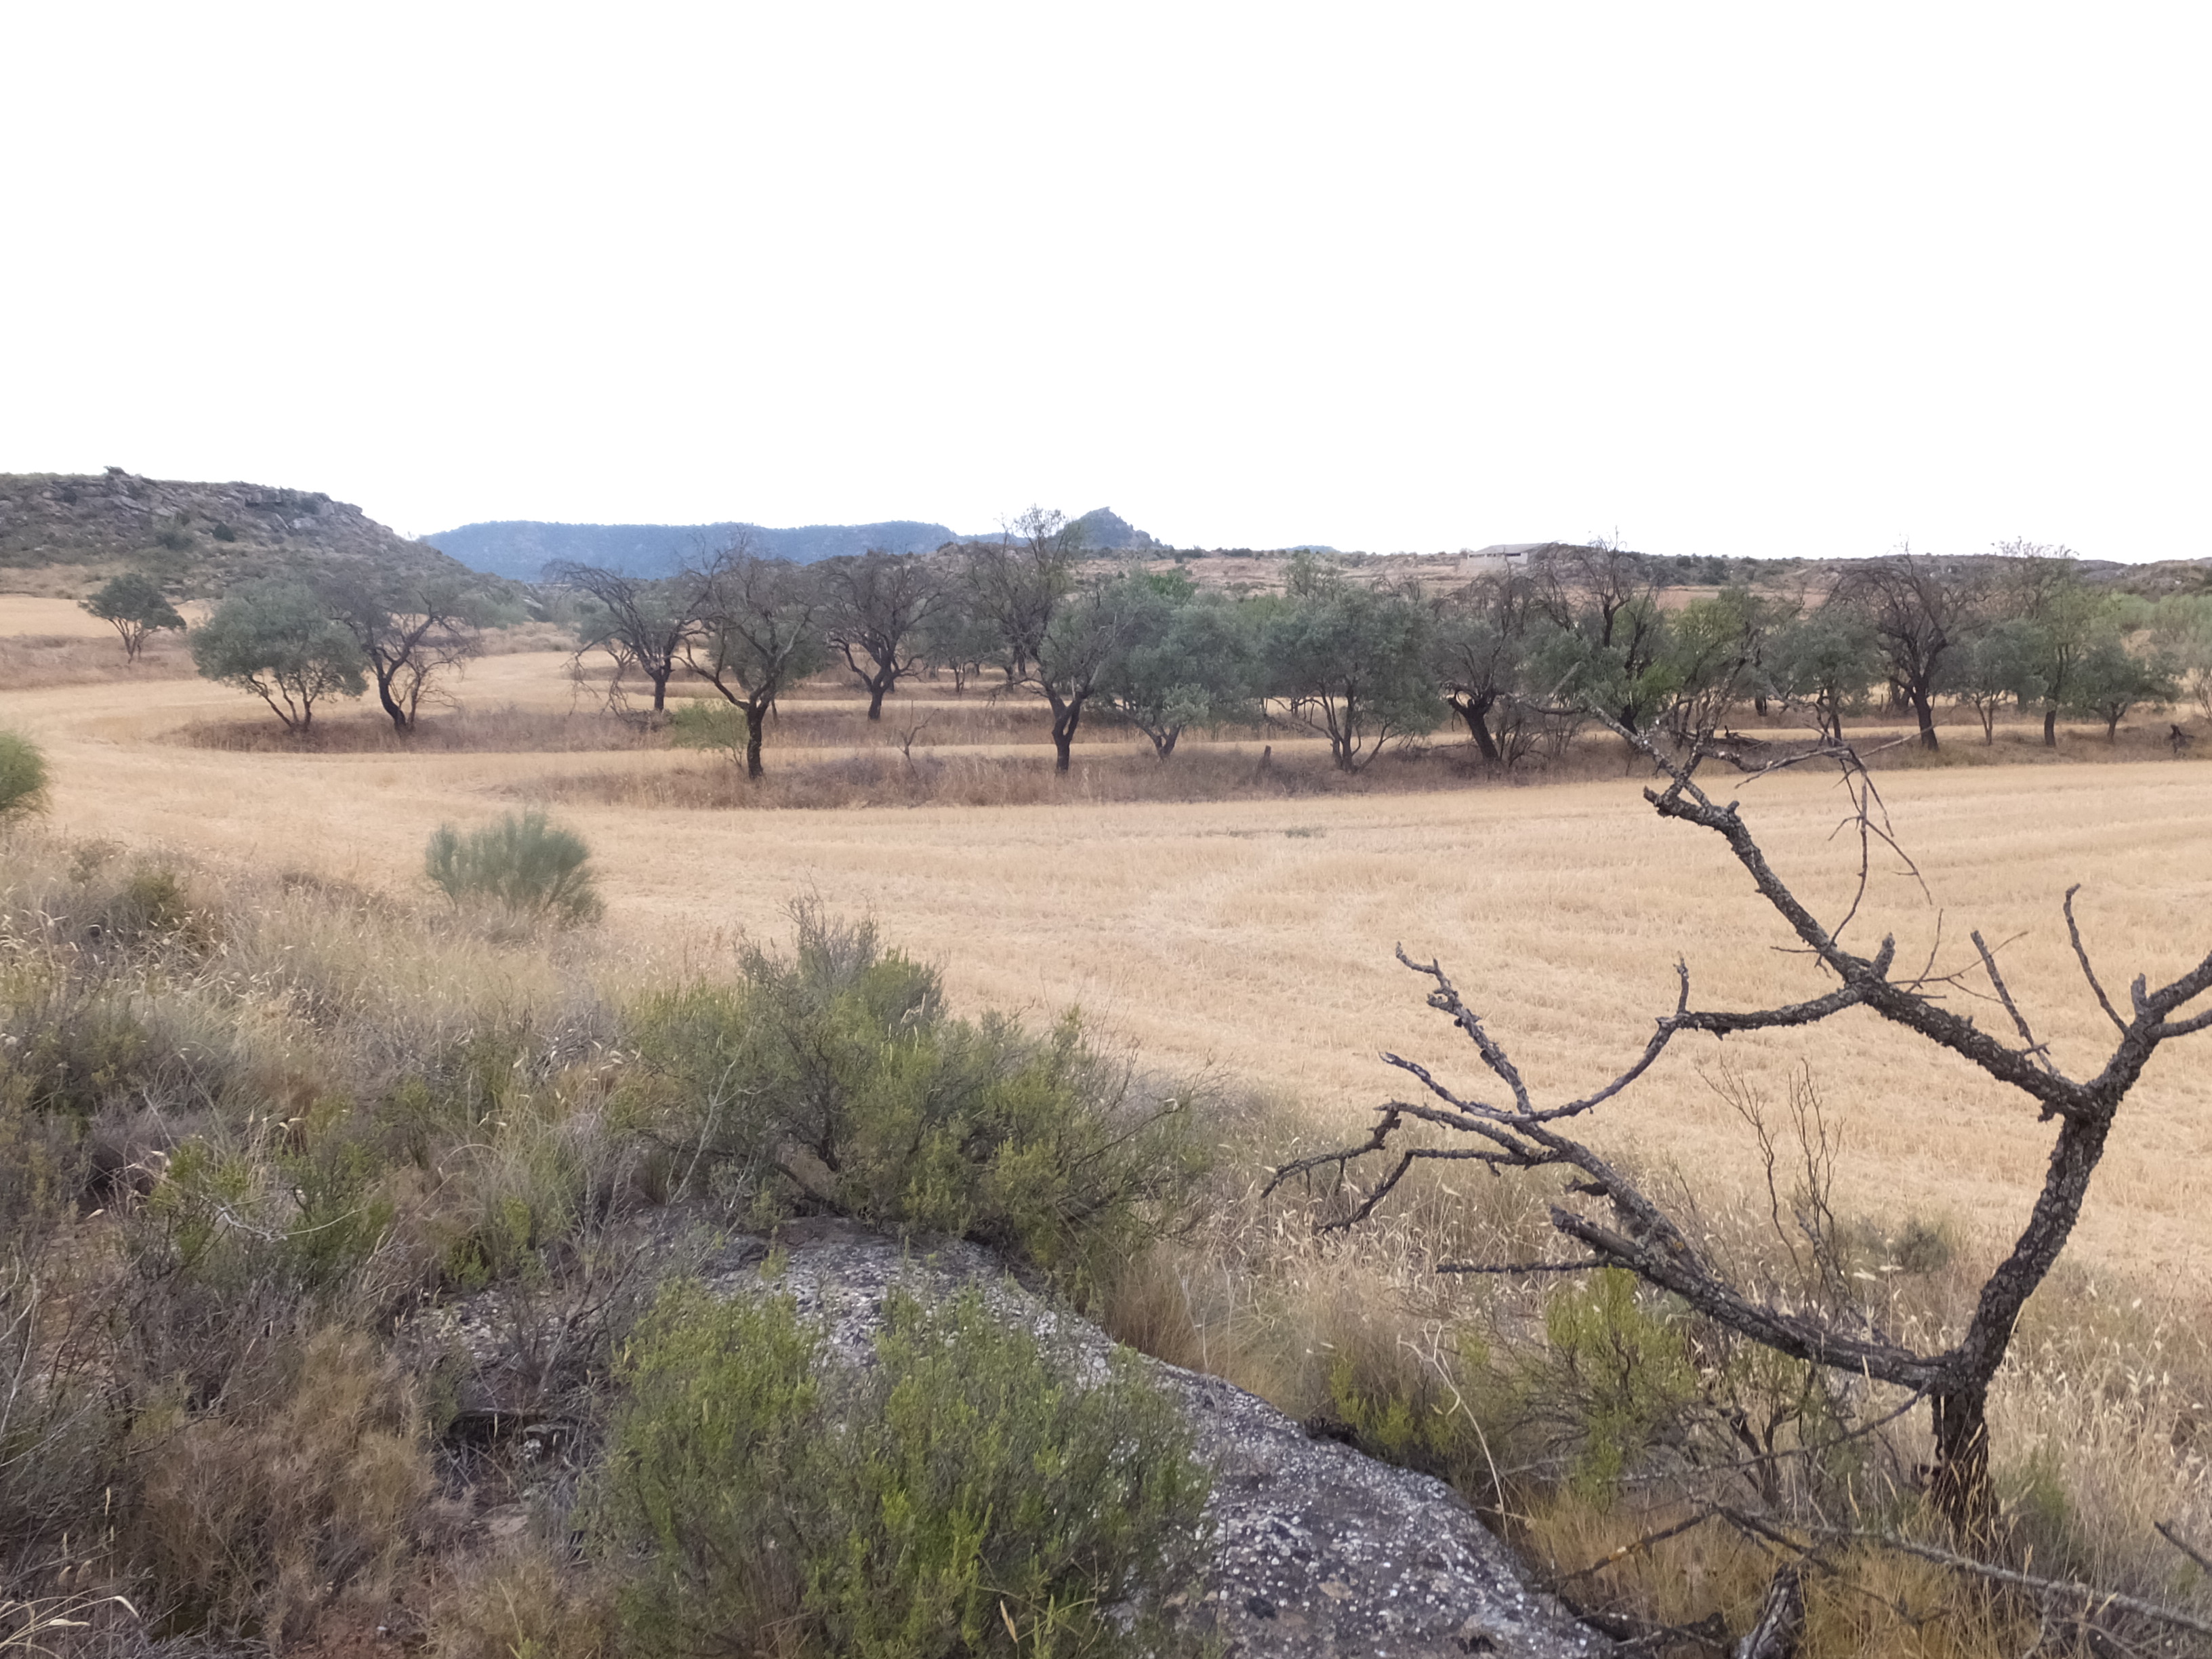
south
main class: Shrubland
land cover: Shrubland without tree cover
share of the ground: > 75 %
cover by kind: shrubs 50 %, herbaceous plants 50 %
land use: Semi-natural and natural areas not in use
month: July
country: ES
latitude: 41.1850
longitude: -0.0863
